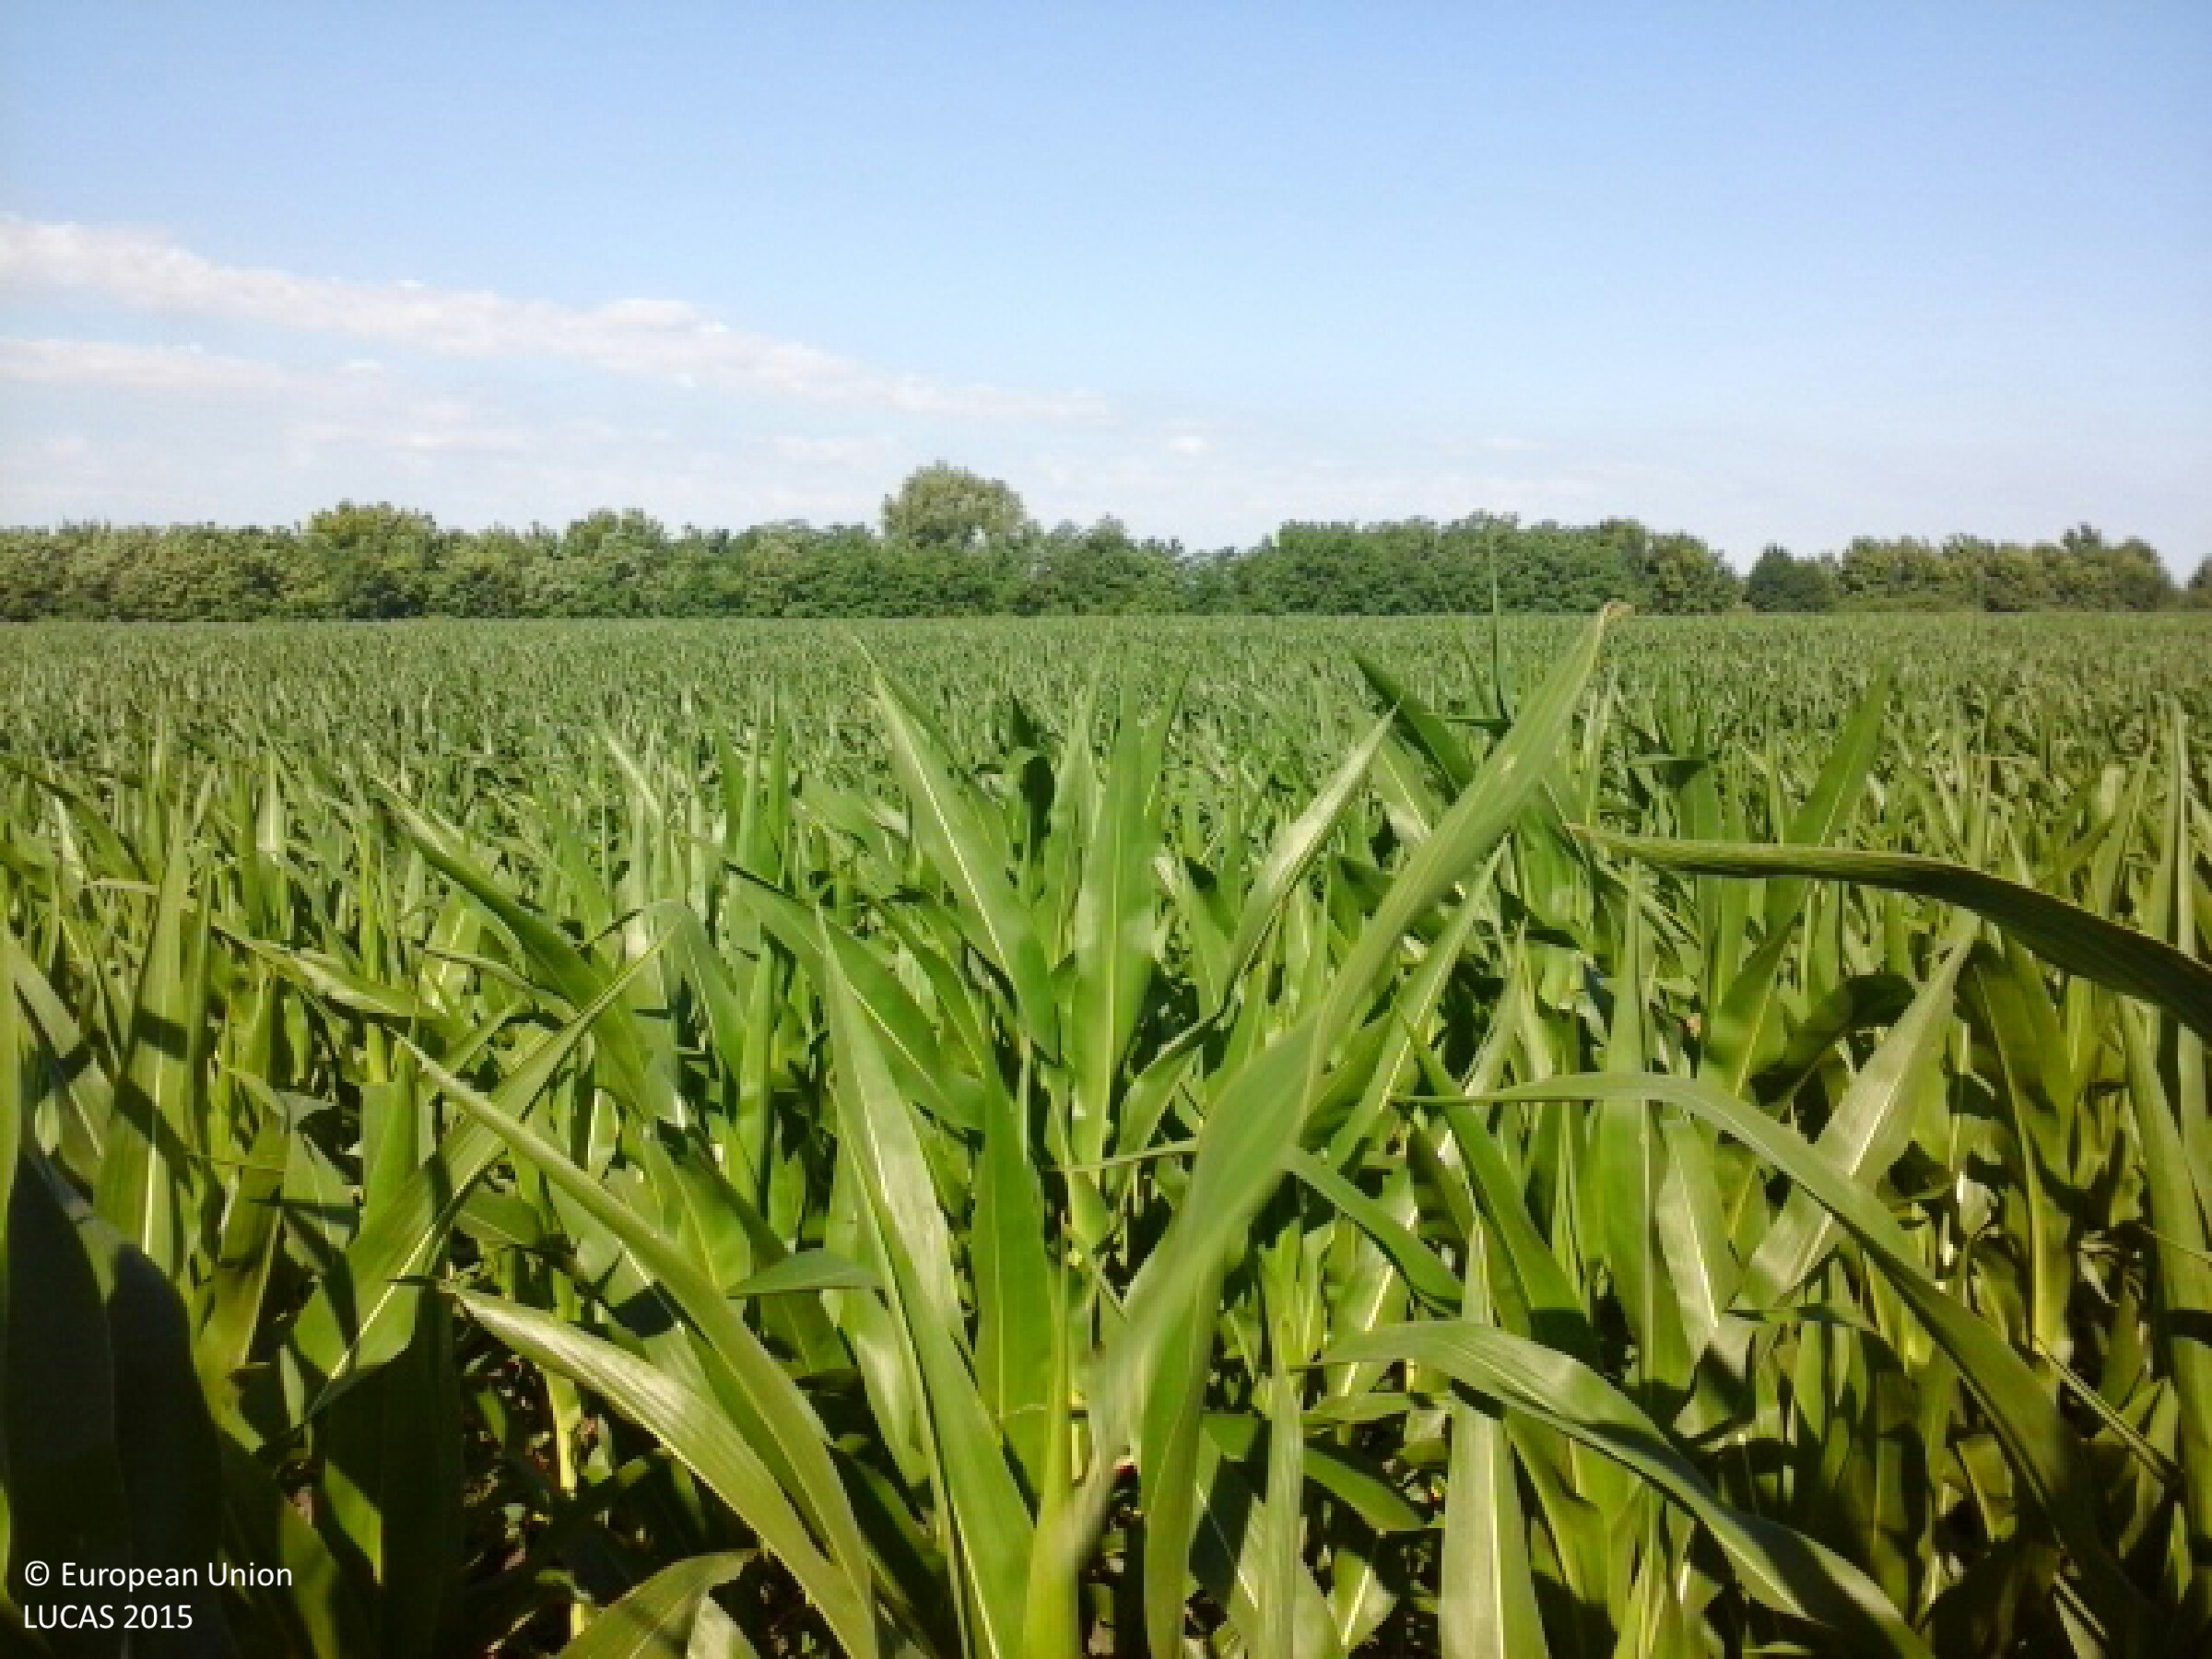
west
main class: Cropland
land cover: Maize
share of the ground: > 75 %
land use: Agriculture (excluding fallow land and kitchen gardens)
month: July
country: HU
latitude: 48.2033
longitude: 21.9877
